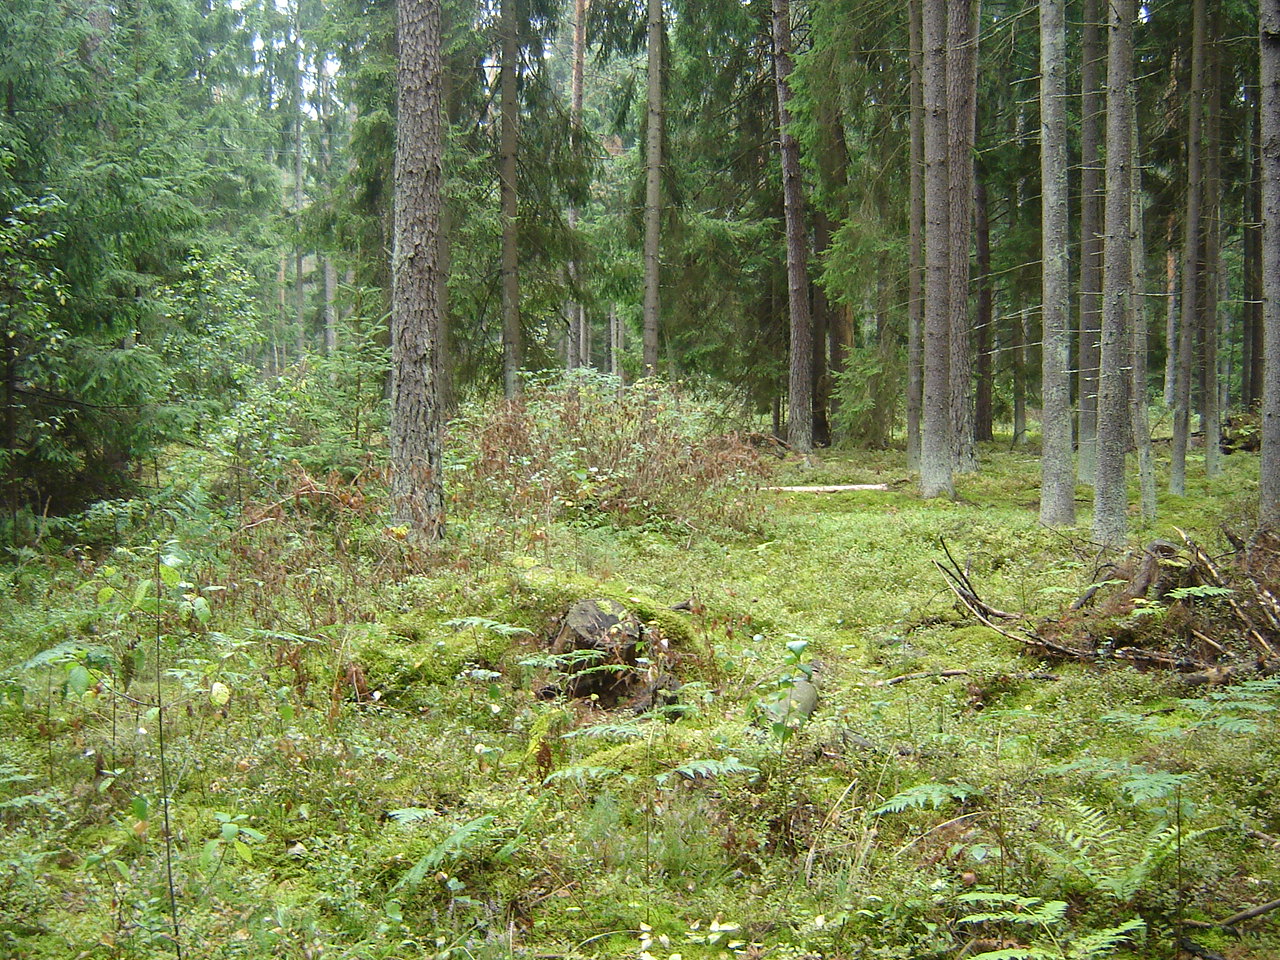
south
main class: Woodland
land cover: Pine dominated coniferous woodland
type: hemiboreal forest and nemoral coniferous forest and mixed broadleaved-coniferous forest
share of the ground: > 75 %
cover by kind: coniferous forest trees 75 %, shrubs 15 %, broadleaved forest trees 5 %, lichens and mosses 5 %
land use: Forestry
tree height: > 5 m
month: September
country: LT
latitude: 54.2713
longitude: 24.7117
